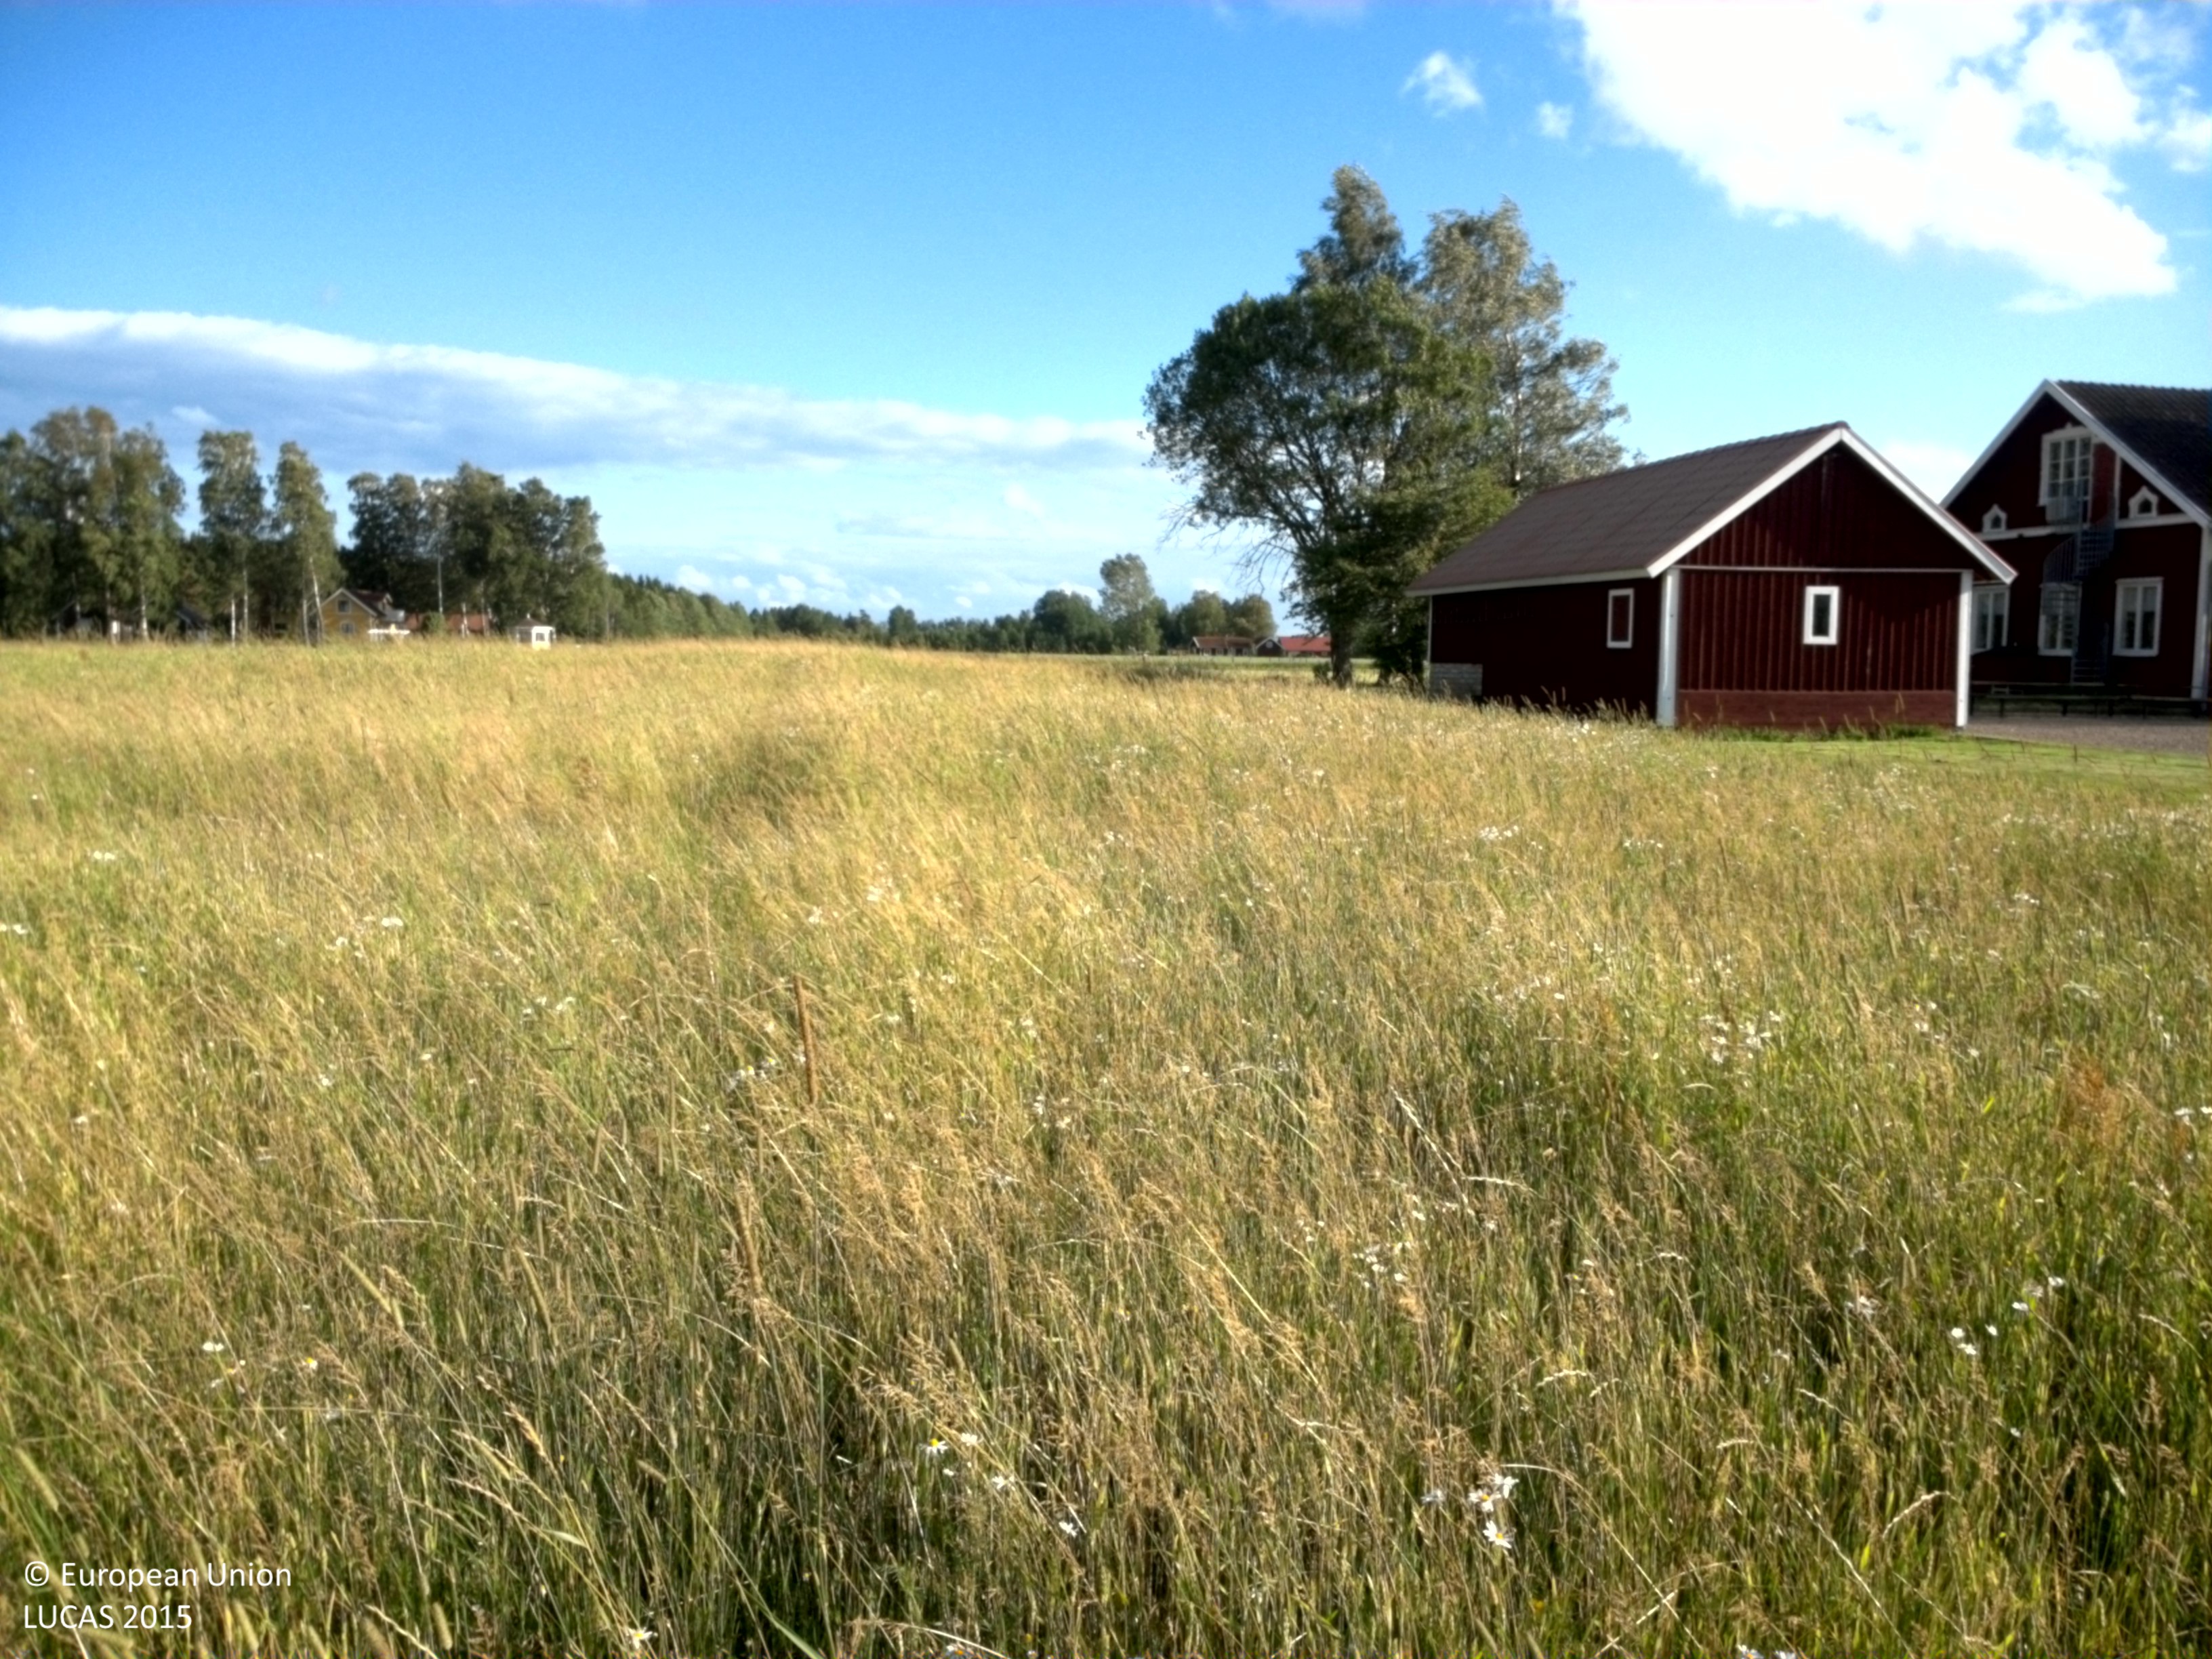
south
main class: Cropland
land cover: Common wheat
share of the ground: > 75 %
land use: Agriculture (excluding fallow land and kitchen gardens)
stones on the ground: > 50 %
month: July
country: SE
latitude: 58.3788
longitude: 13.9098
